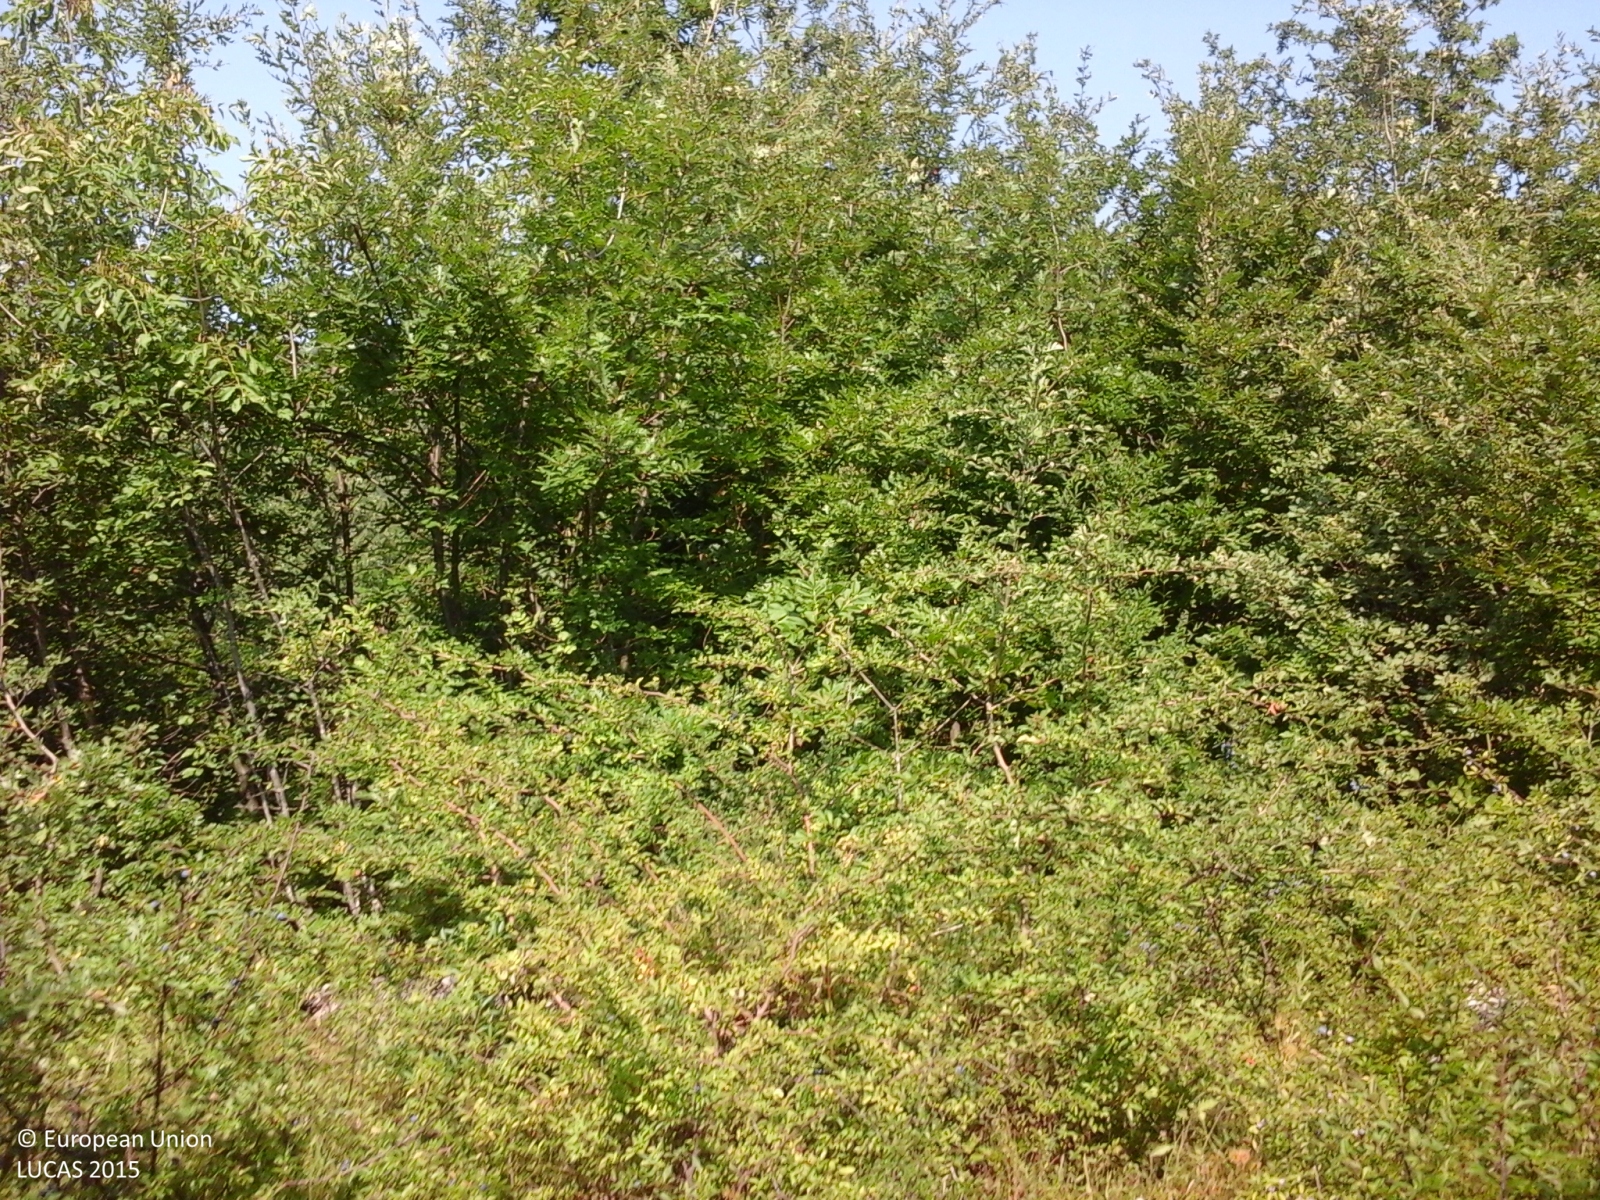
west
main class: Woodland
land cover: Broadleaved woodland
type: thermophilous deciduous forest
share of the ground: > 75 %
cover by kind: broadleaved forest trees 100 %
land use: Forestry
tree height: > 5 m
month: August
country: IT
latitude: 43.7297
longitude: 12.2910
